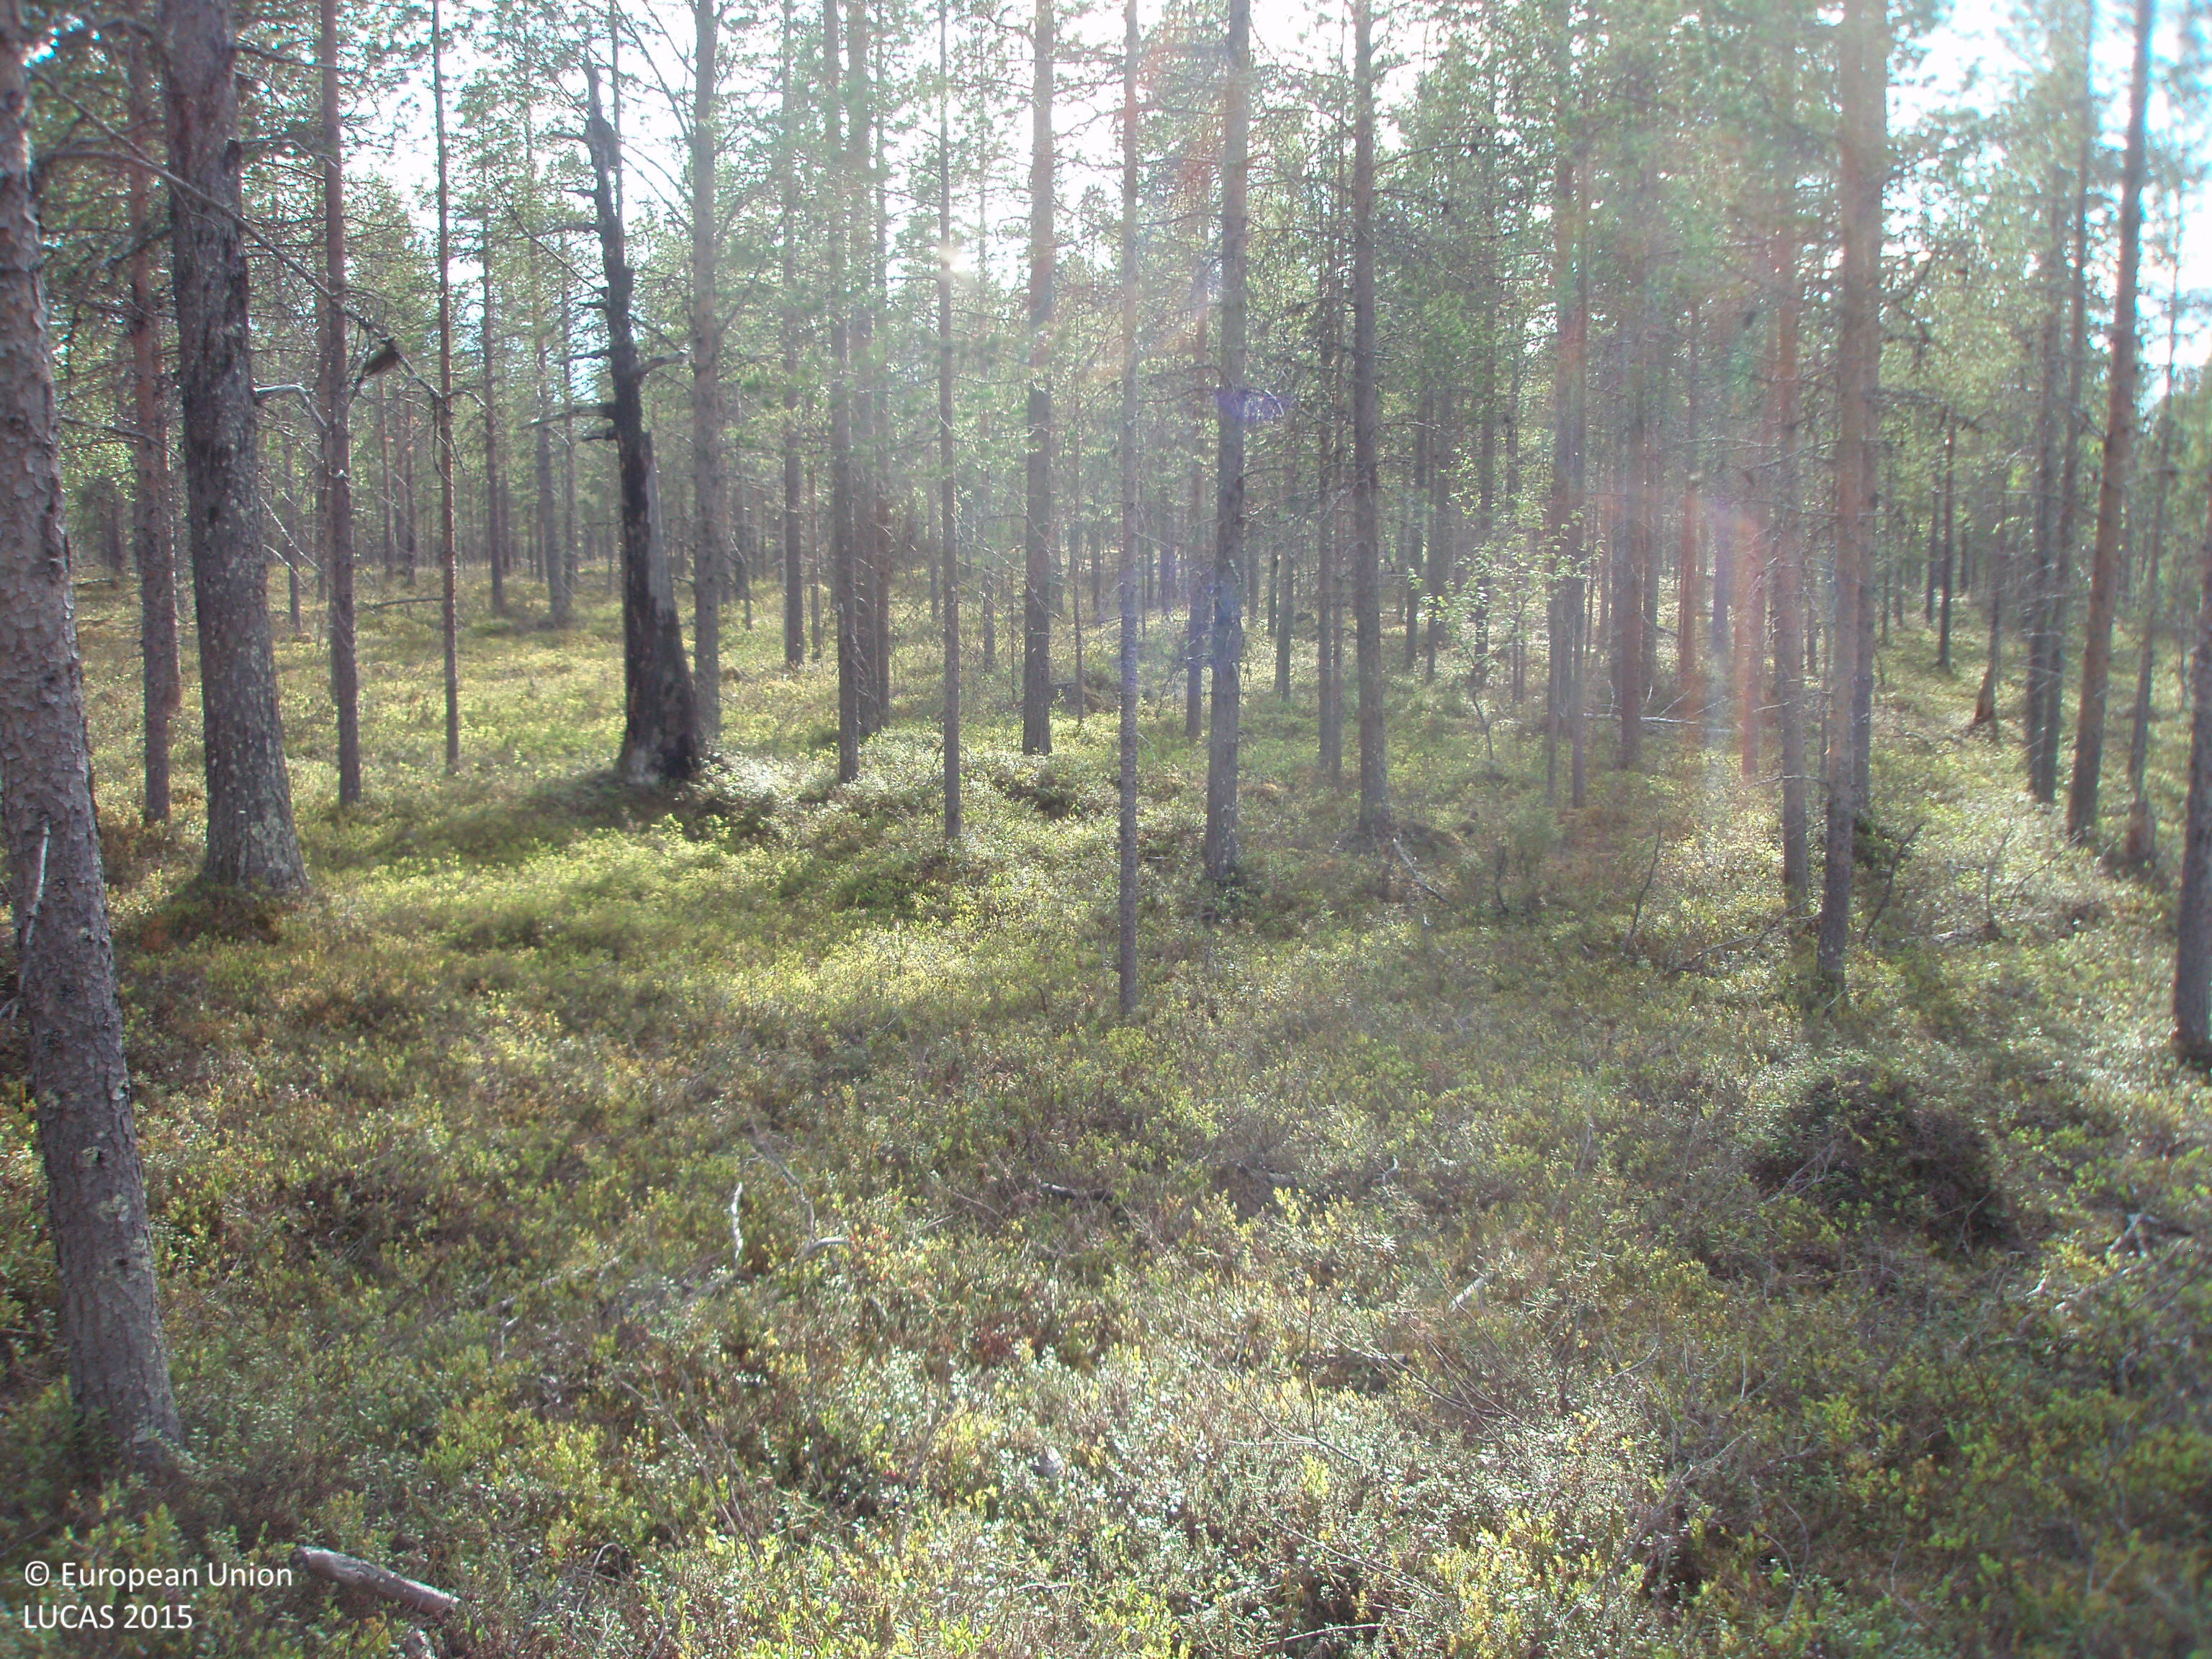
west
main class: Woodland
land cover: Pine dominated coniferous woodland
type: boreal forest
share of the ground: > 75 %
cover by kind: coniferous forest trees 75 %, shrubs 20 %, lichens and mosses 5 %
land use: Forestry
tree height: > 5 m
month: June
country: FI
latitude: 68.7278
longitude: 28.5062
